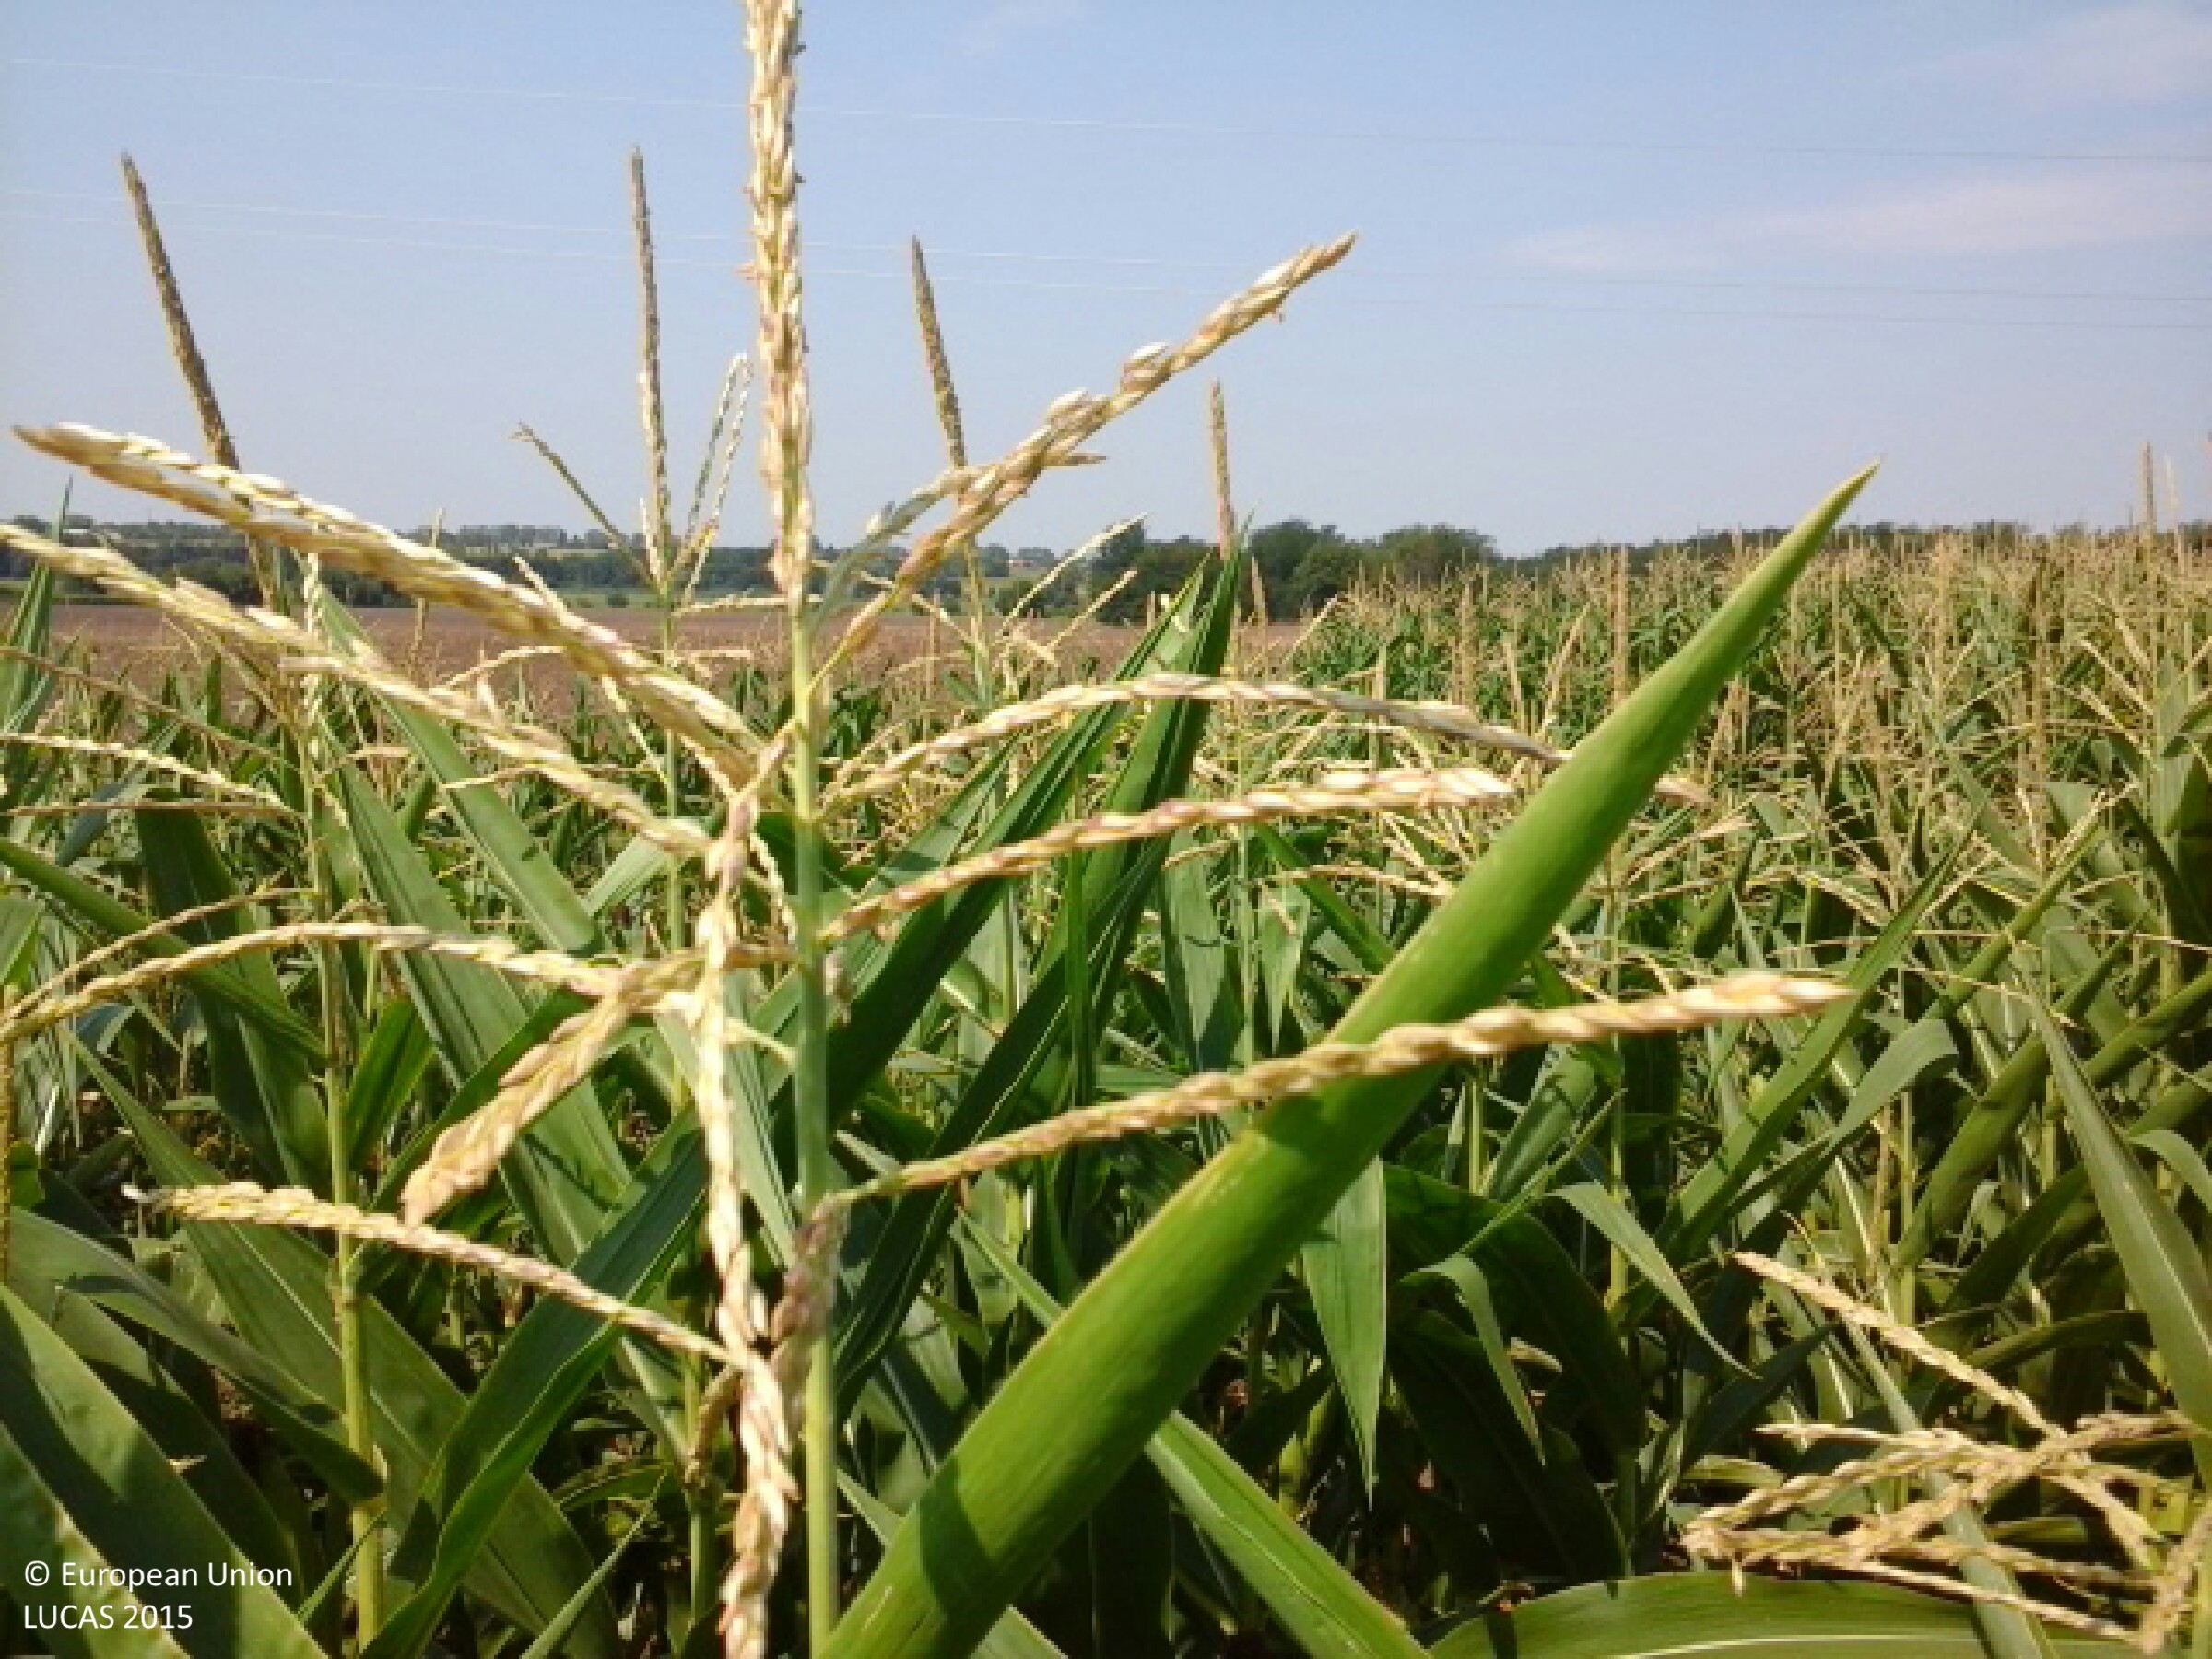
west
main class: Cropland
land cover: Maize
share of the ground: > 75 %
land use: Agriculture (excluding fallow land and kitchen gardens)
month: August
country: HU
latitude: 47.5829
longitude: 18.0822
